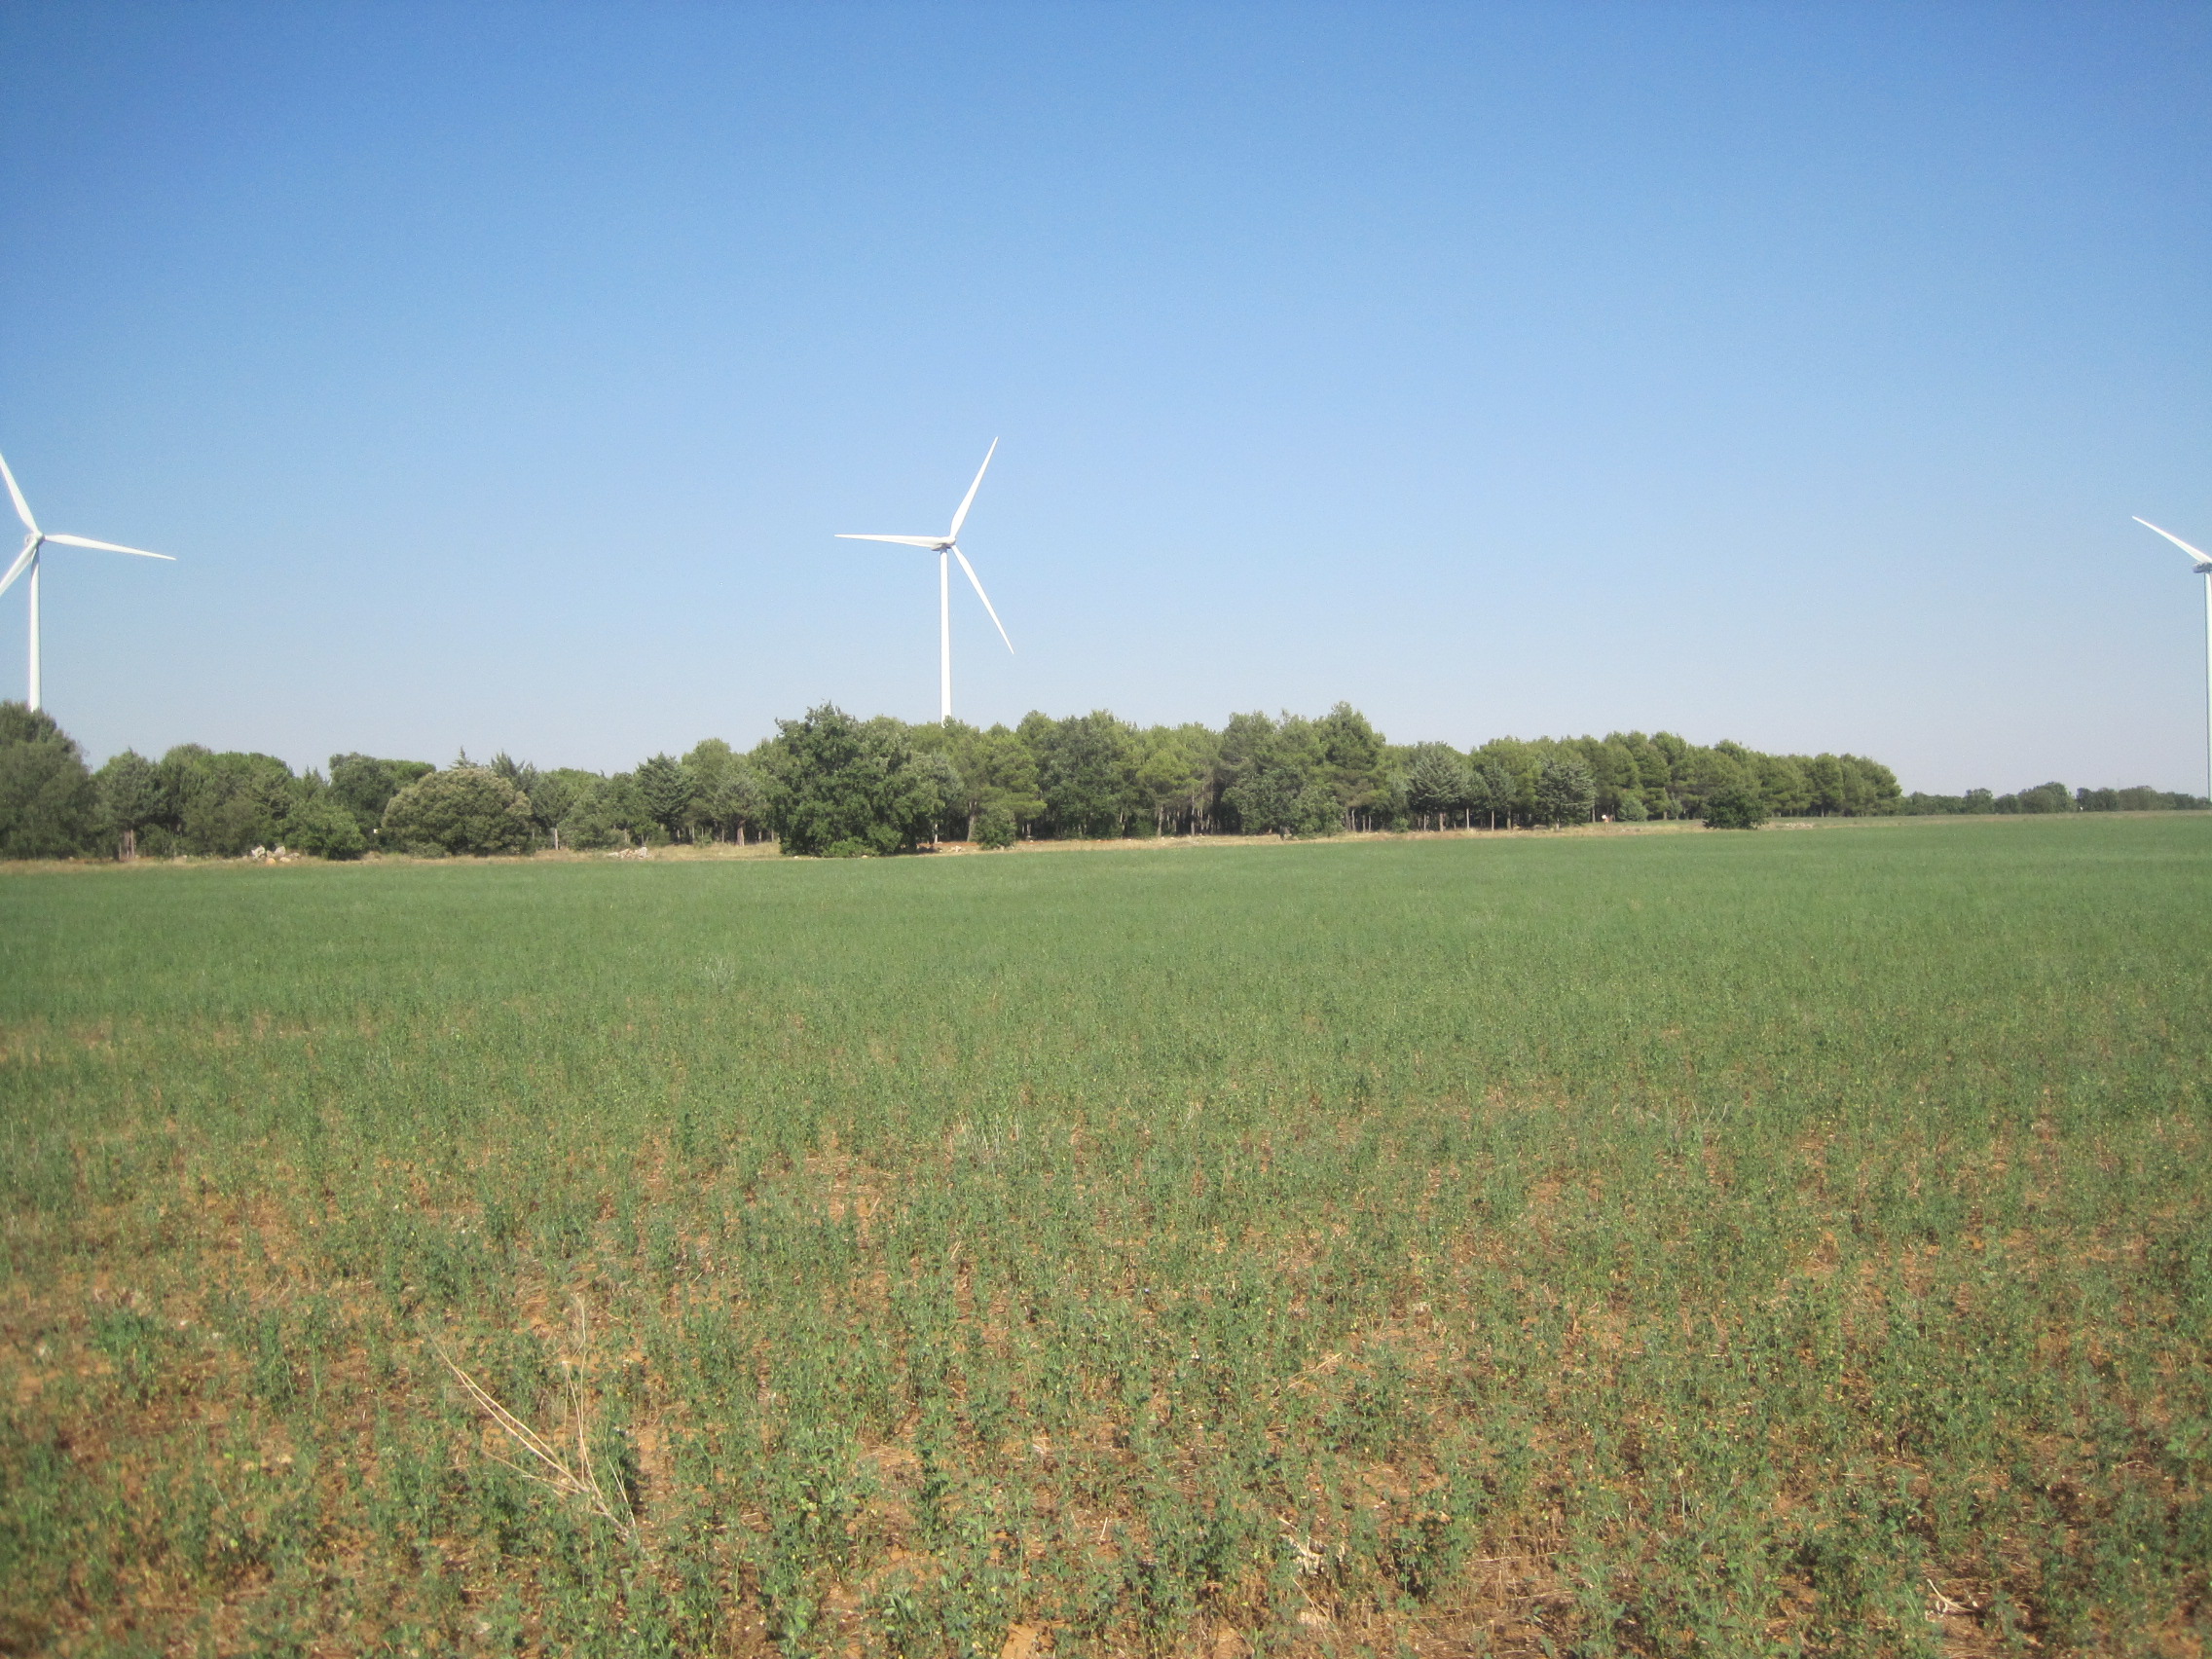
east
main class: Cropland
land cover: Lucerne
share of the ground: > 75 %
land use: Agriculture (excluding fallow land and kitchen gardens)
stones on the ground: 25 - 50 %
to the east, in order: Lucerne; Grassland with sparse tree/shrub cover; Tracks; Pine dominated mixed woodland
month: July
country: ES
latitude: 41.8773
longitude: -4.7611
